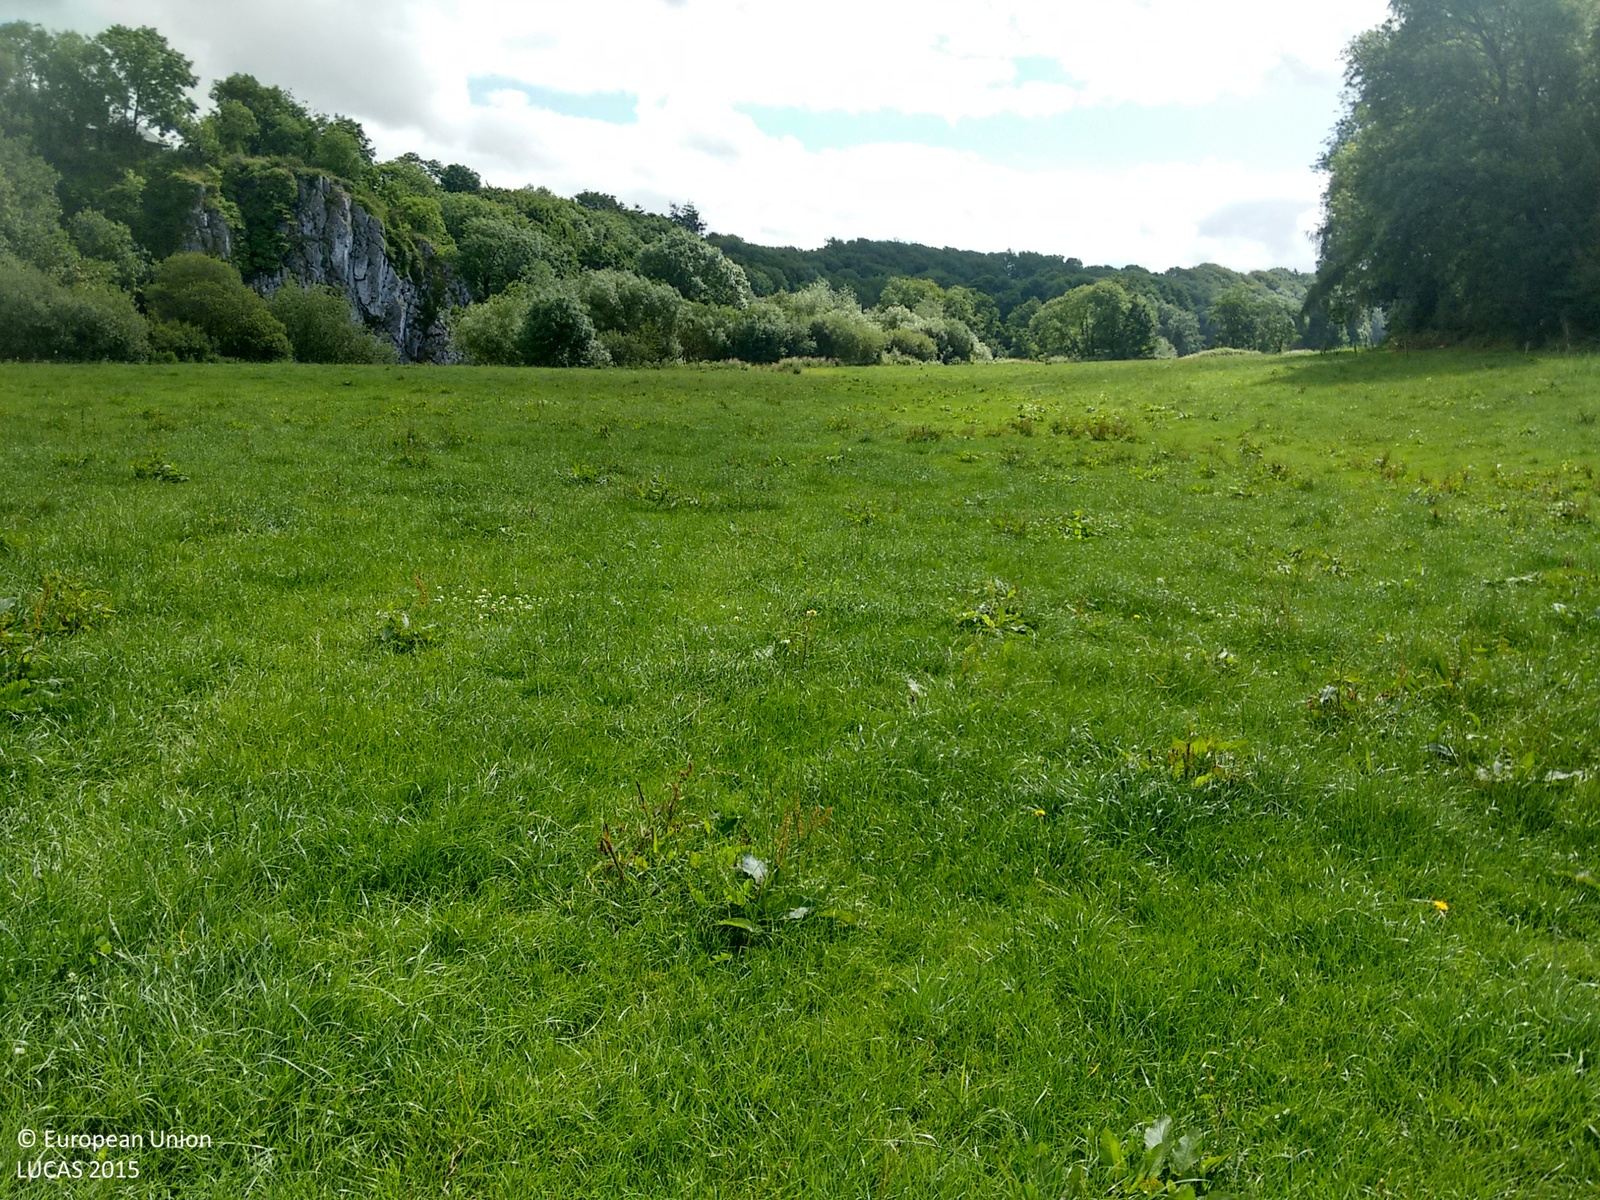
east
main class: Grassland
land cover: Grassland without tree/shrub cover
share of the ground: > 75 %
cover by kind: herbaceous plants 100 %
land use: Agriculture (excluding fallow land and kitchen gardens)
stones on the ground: < 10 %
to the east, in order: Grassland without tree/shrub cover; Fences; Shruby margins; Broadleaved woodland; Grass margins; Inland fresh running water; Broadleaved woodland; Grassland without tree/shrub cover
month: July
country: IE
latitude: 52.1506
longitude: -8.4462
